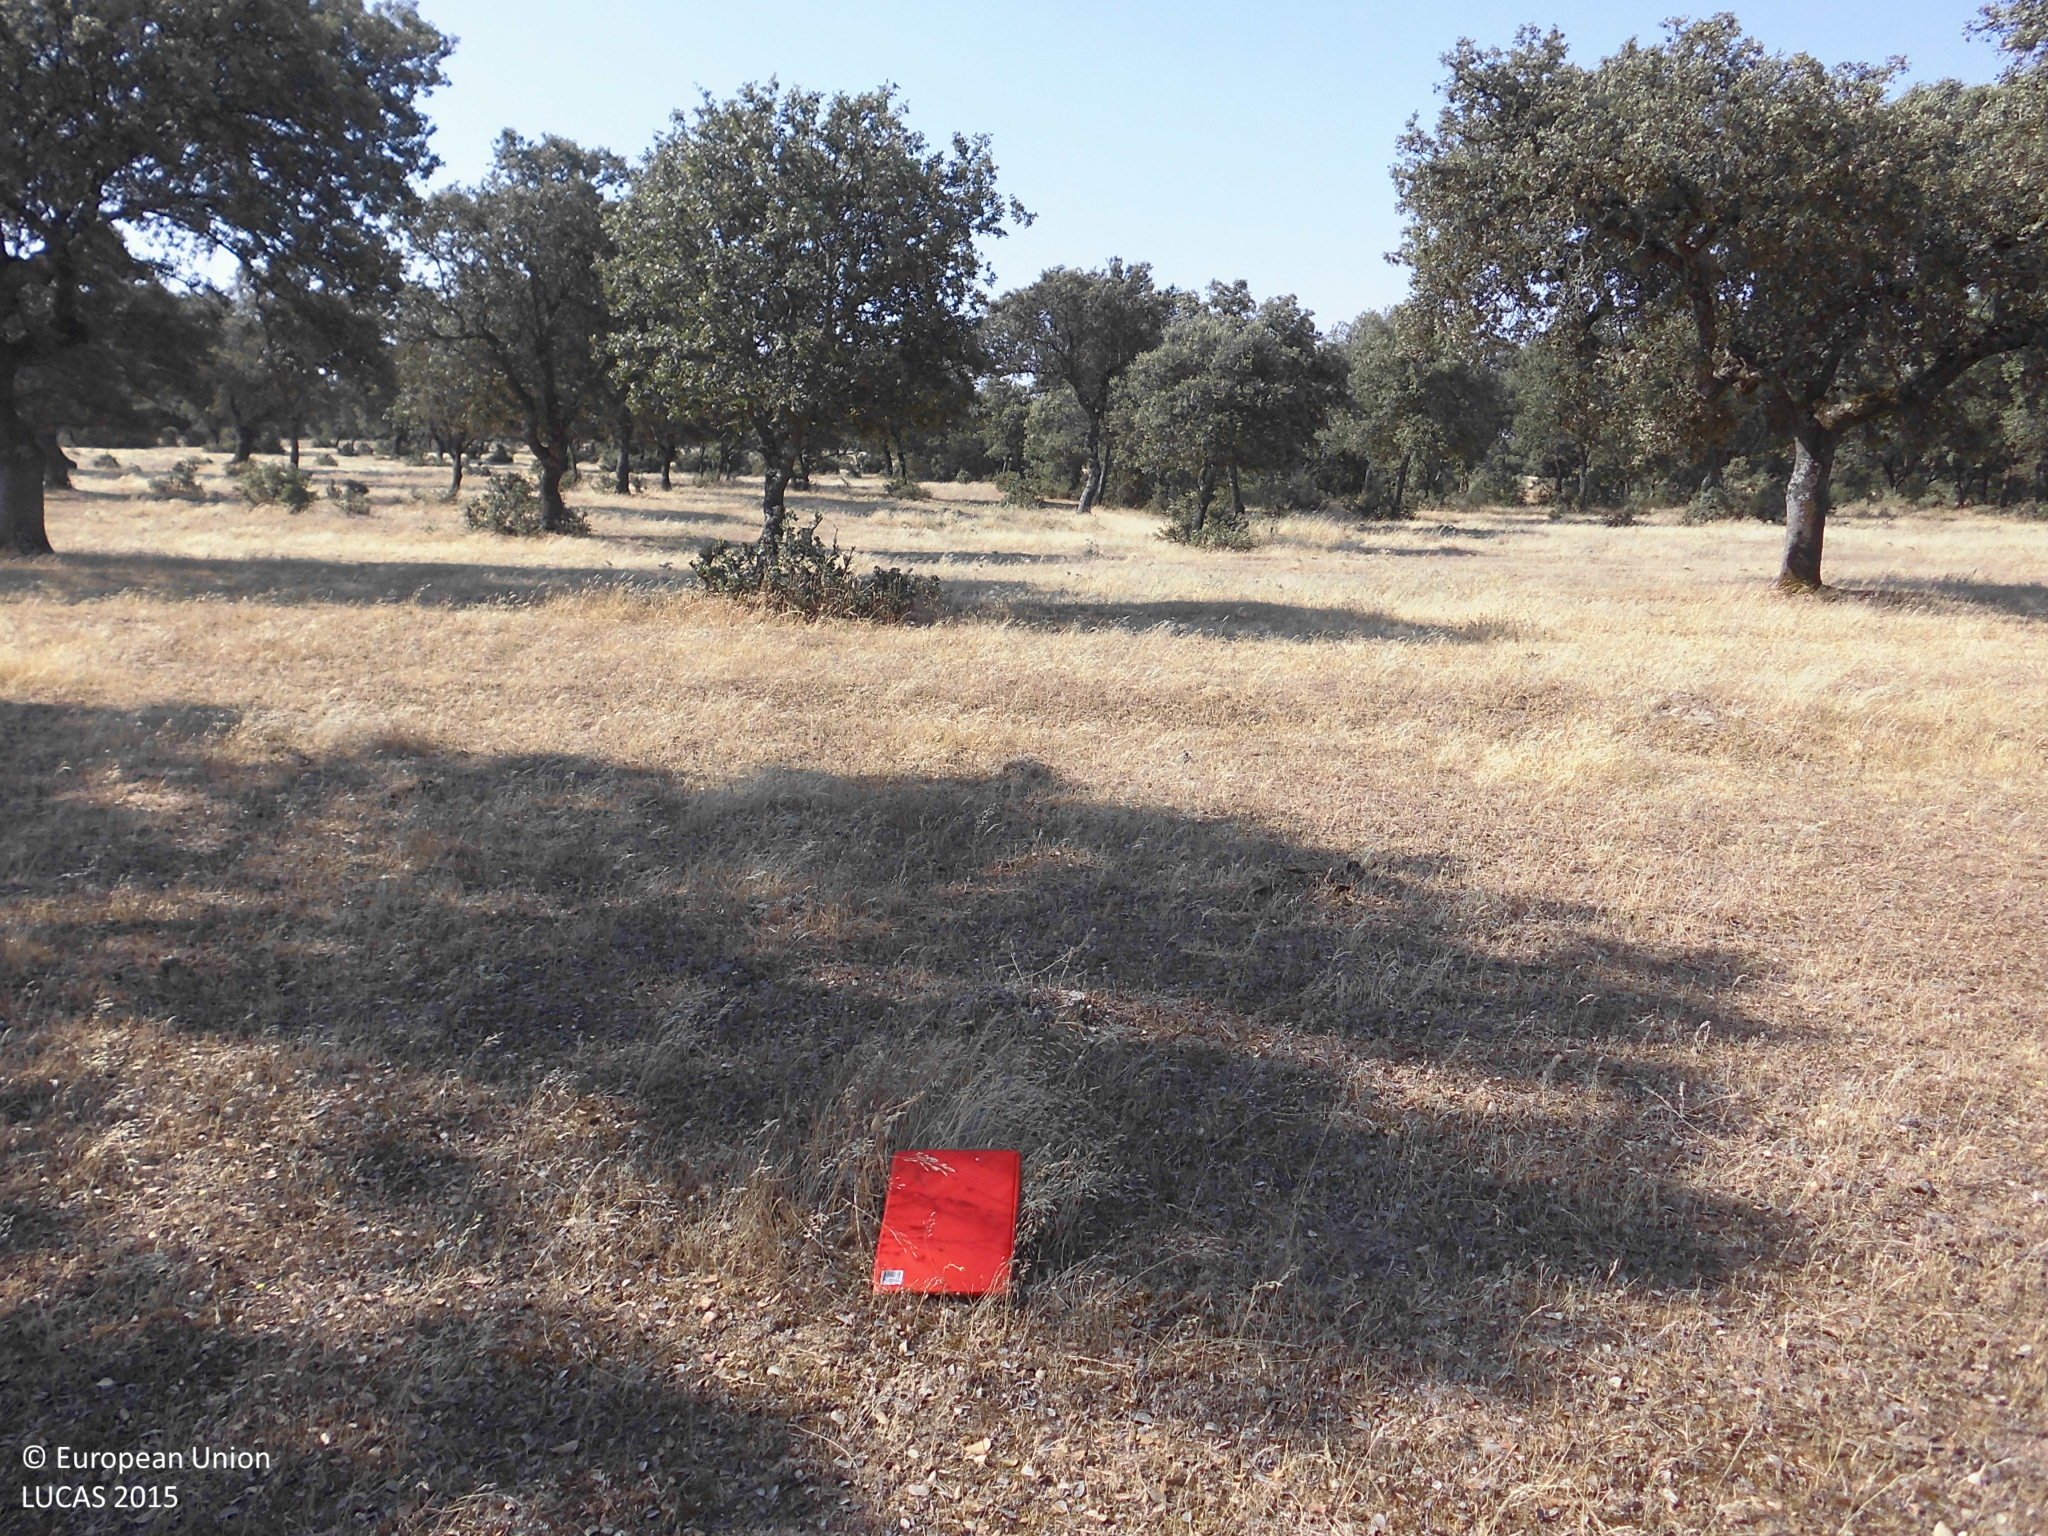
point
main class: Woodland
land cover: Broadleaved woodland
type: broadleaved evergreen forest
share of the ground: 10 - 25 %
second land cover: Grassland without tree/shrub cover
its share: > 75 %
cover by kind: herbaceous plants 85 %, broadleaved forest trees 15 %
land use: Forestry
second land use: Agriculture (excluding fallow land and kitchen gardens)
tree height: > 5 m
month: June
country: ES
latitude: 39.9468
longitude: -5.4967
